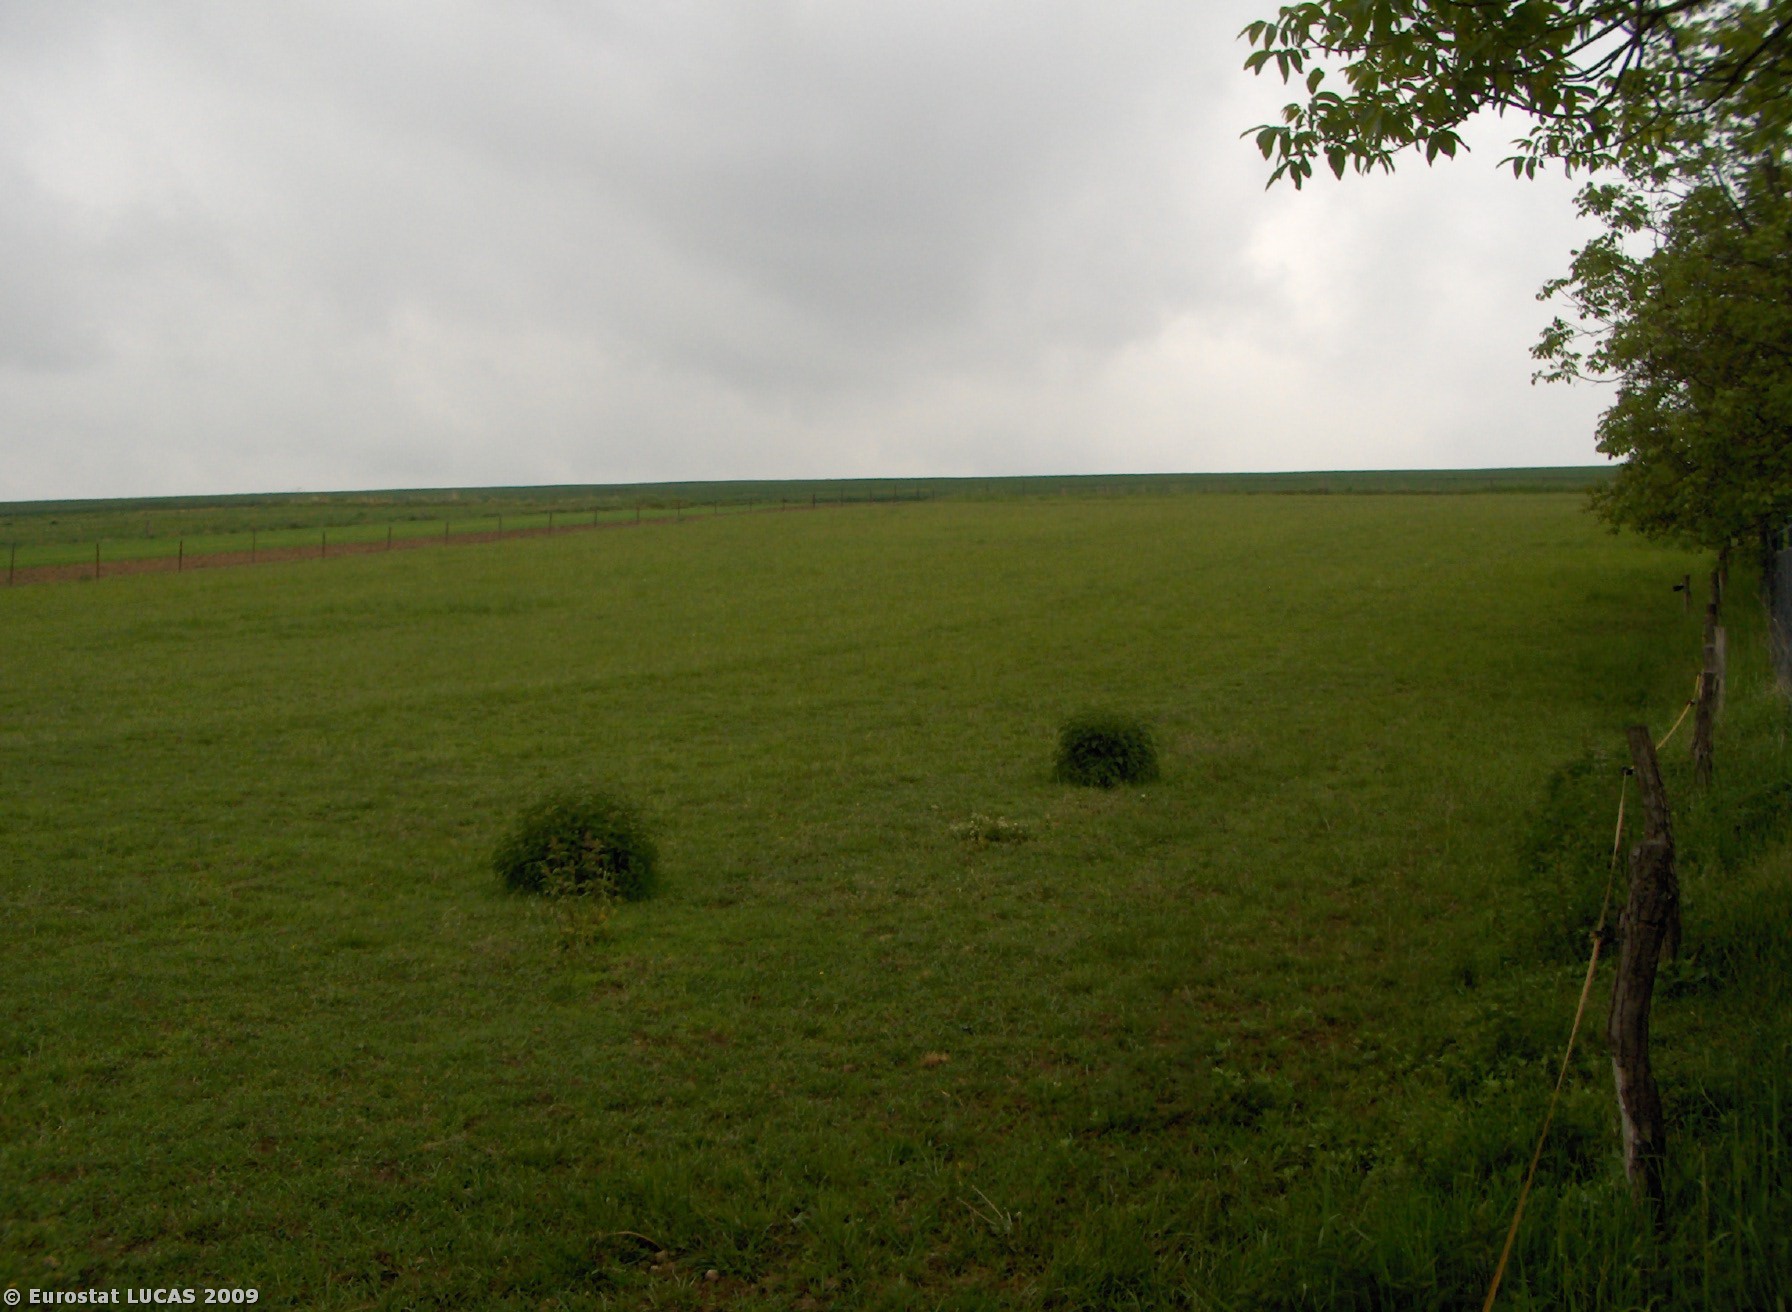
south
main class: Grassland
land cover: Grassland with sparse tree/shrub cover
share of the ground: > 75 %
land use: Agriculture (excluding fallow land and kitchen gardens)
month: May
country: CZ
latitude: 49.3848
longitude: 17.1042
